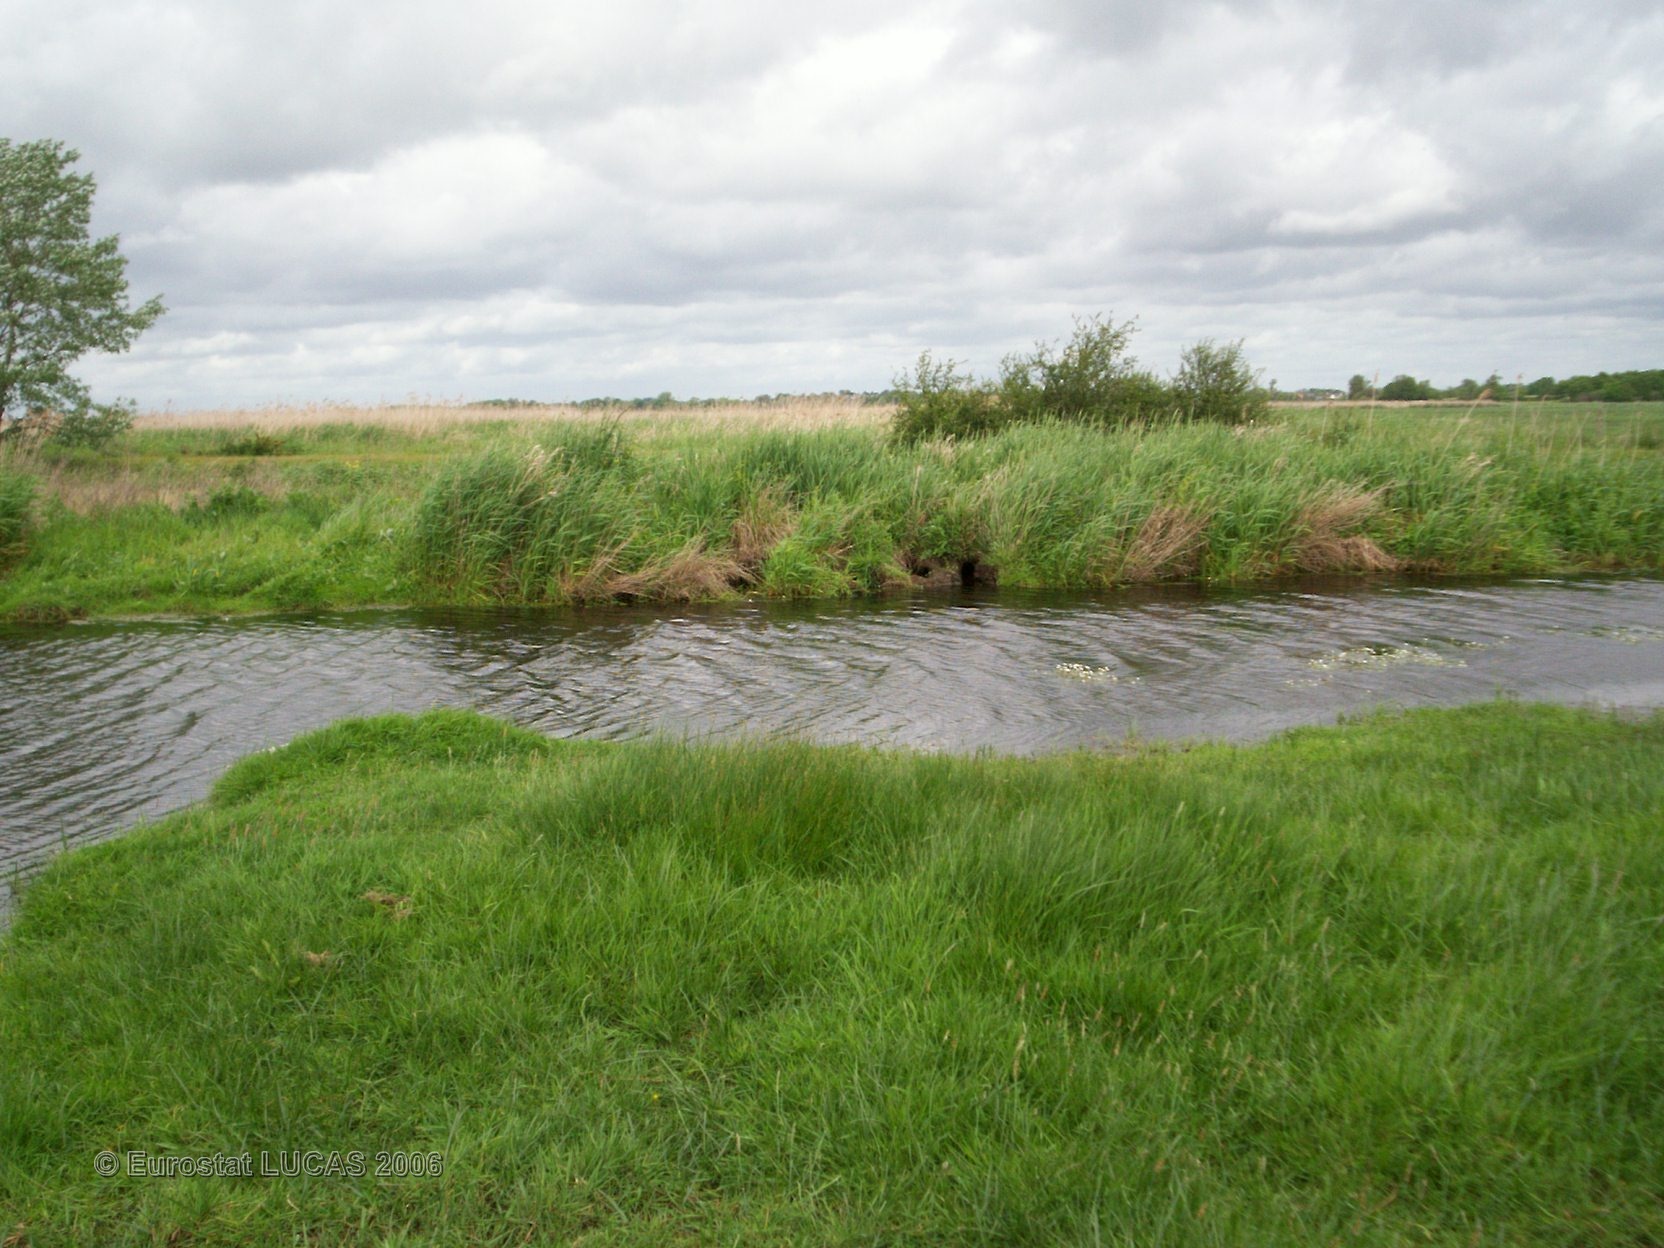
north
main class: Grassland
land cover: Grassland without tree/shrub cover
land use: Agriculture (excluding fallow land and kitchen gardens)
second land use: Wetland
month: May
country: FR
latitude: 47.3677
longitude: -2.1409
